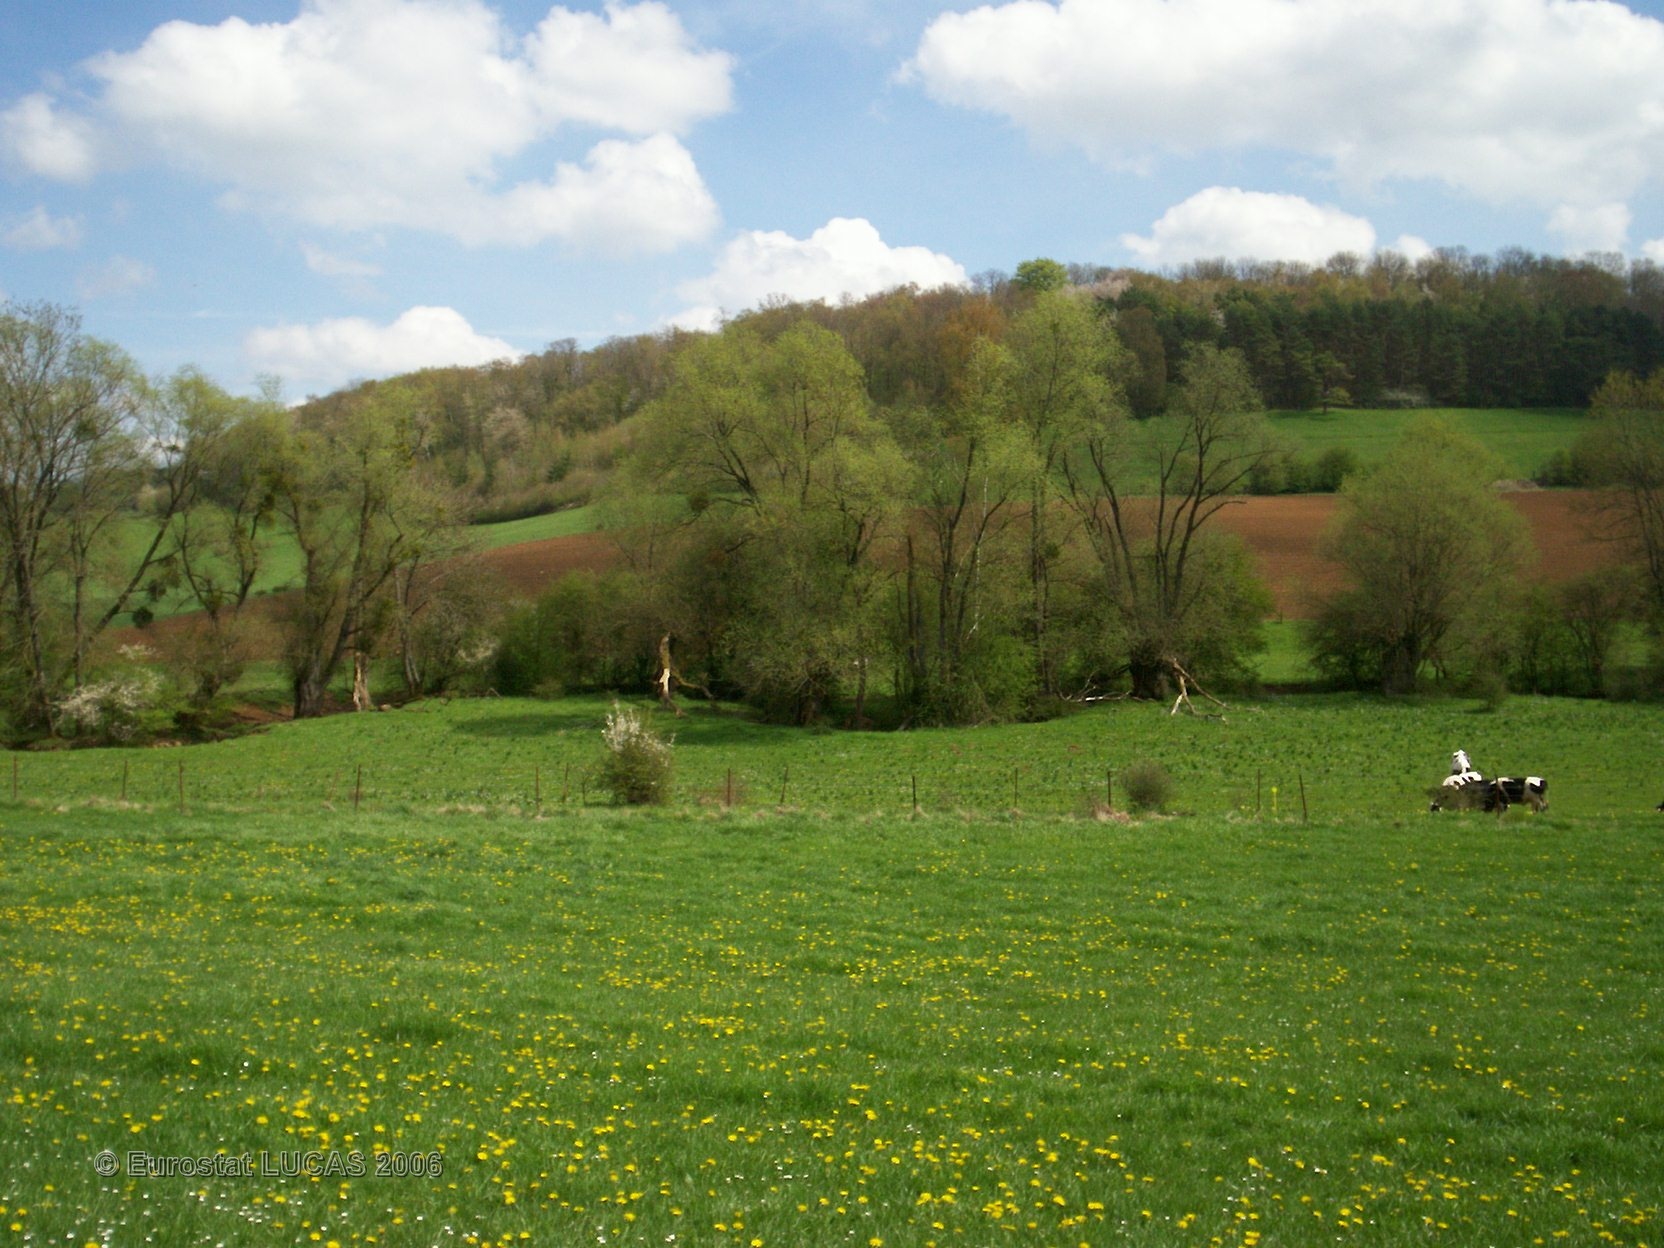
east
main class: Grassland
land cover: Grassland without tree/shrub cover
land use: Agriculture (excluding fallow land and kitchen gardens)
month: May
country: FR
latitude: 49.7942
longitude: 4.3974
